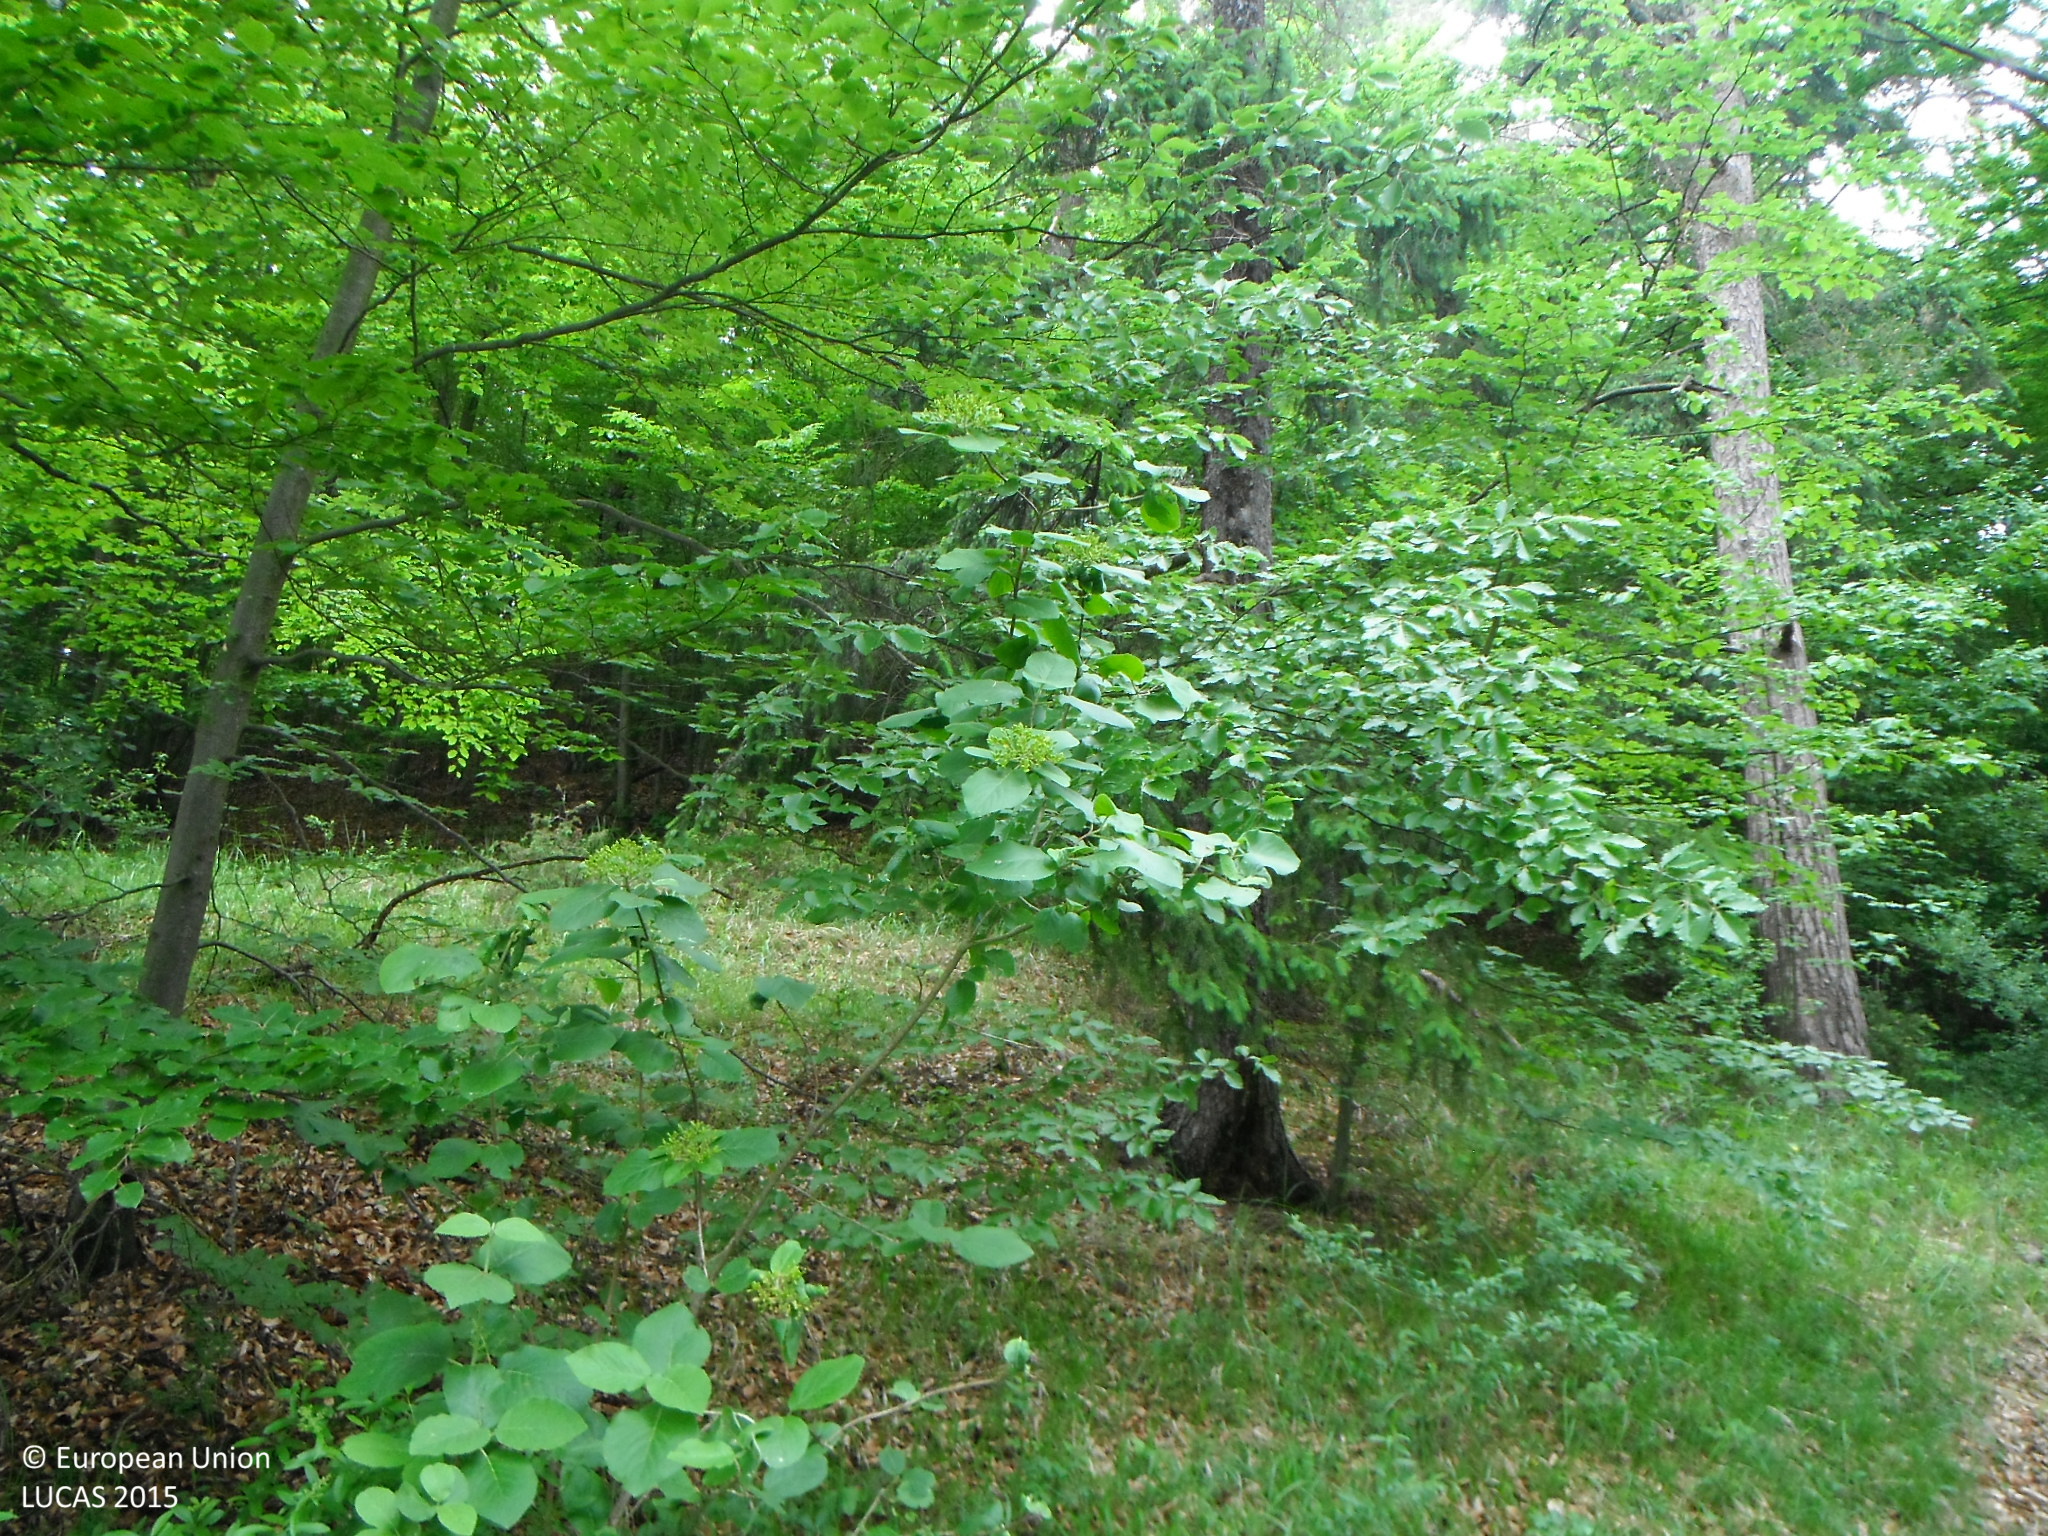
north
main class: Woodland
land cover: Pine dominated mixed woodland
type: hemiboreal forest and nemoral coniferous forest and mixed broadleaved-coniferous forest
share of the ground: > 75 %
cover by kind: coniferous forest trees 75 %, broadleaved forest trees 25 %
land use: Forestry
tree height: > 5 m
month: May
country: SK
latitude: 48.7790
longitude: 19.2087
